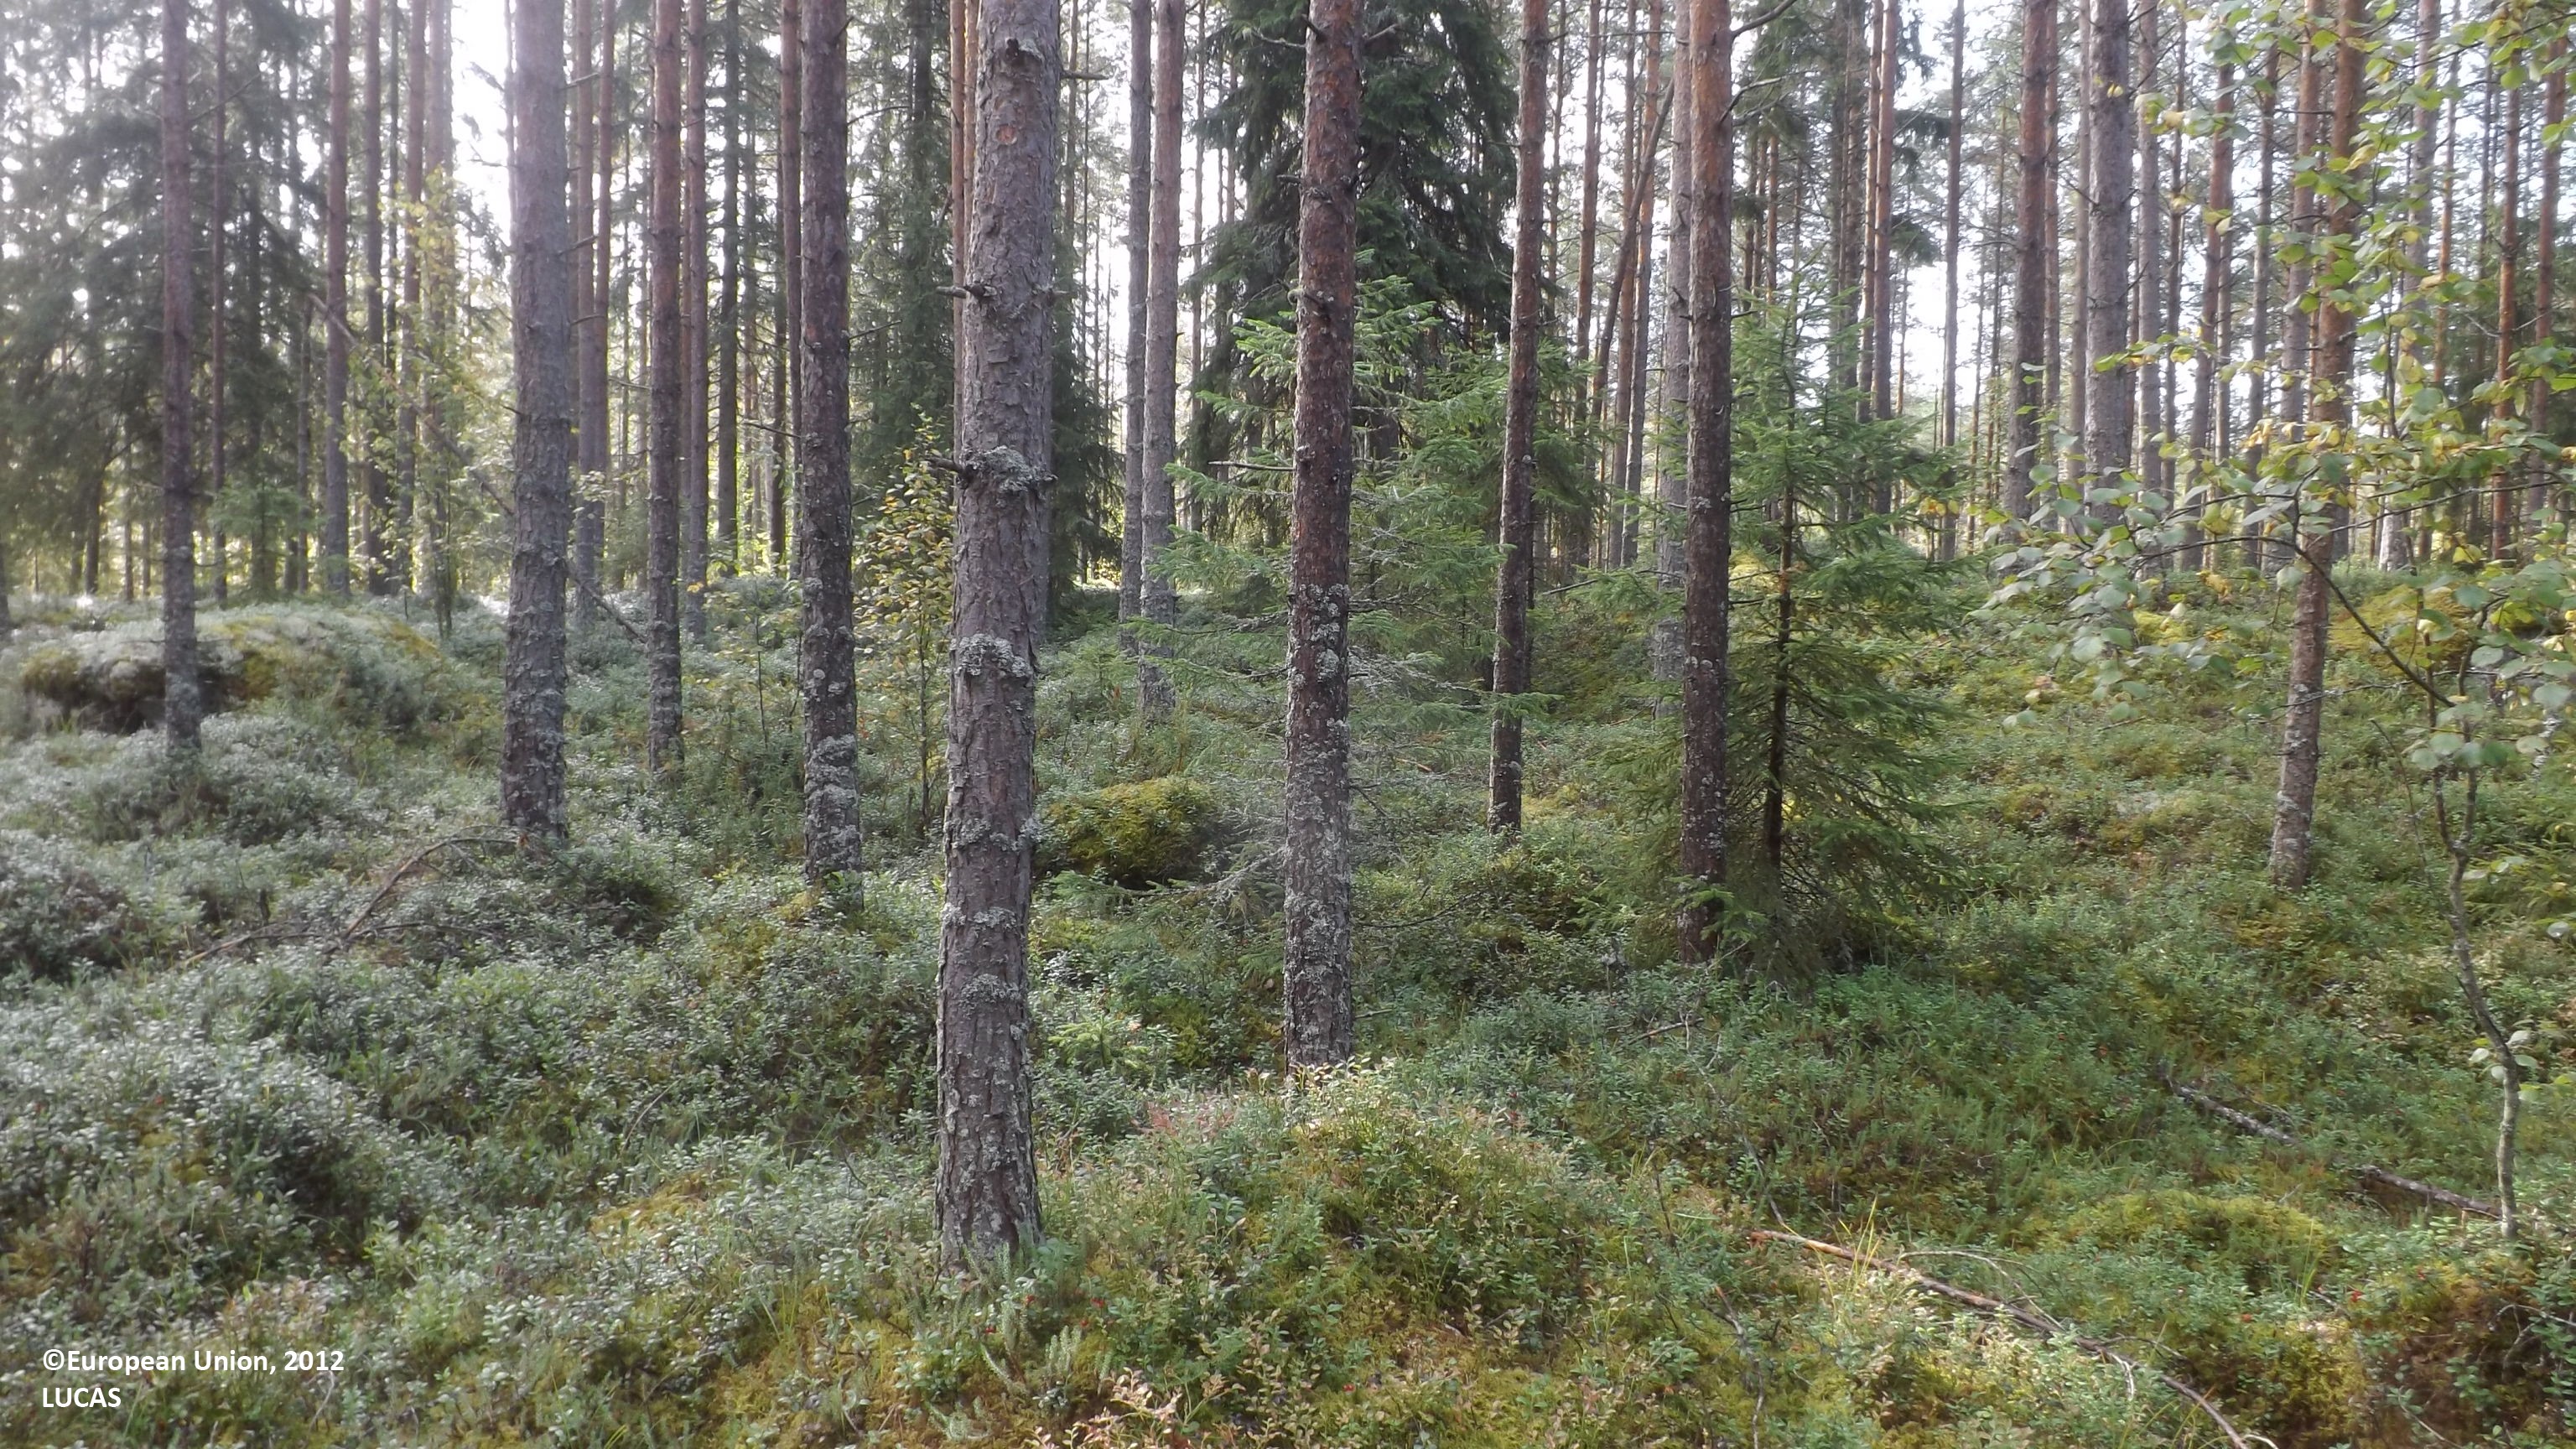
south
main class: Woodland
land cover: Pine dominated coniferous woodland
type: boreal forest
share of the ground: 50 - 75 %
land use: Forestry
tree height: > 5 m
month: August
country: FI
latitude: 63.8510
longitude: 23.5431
